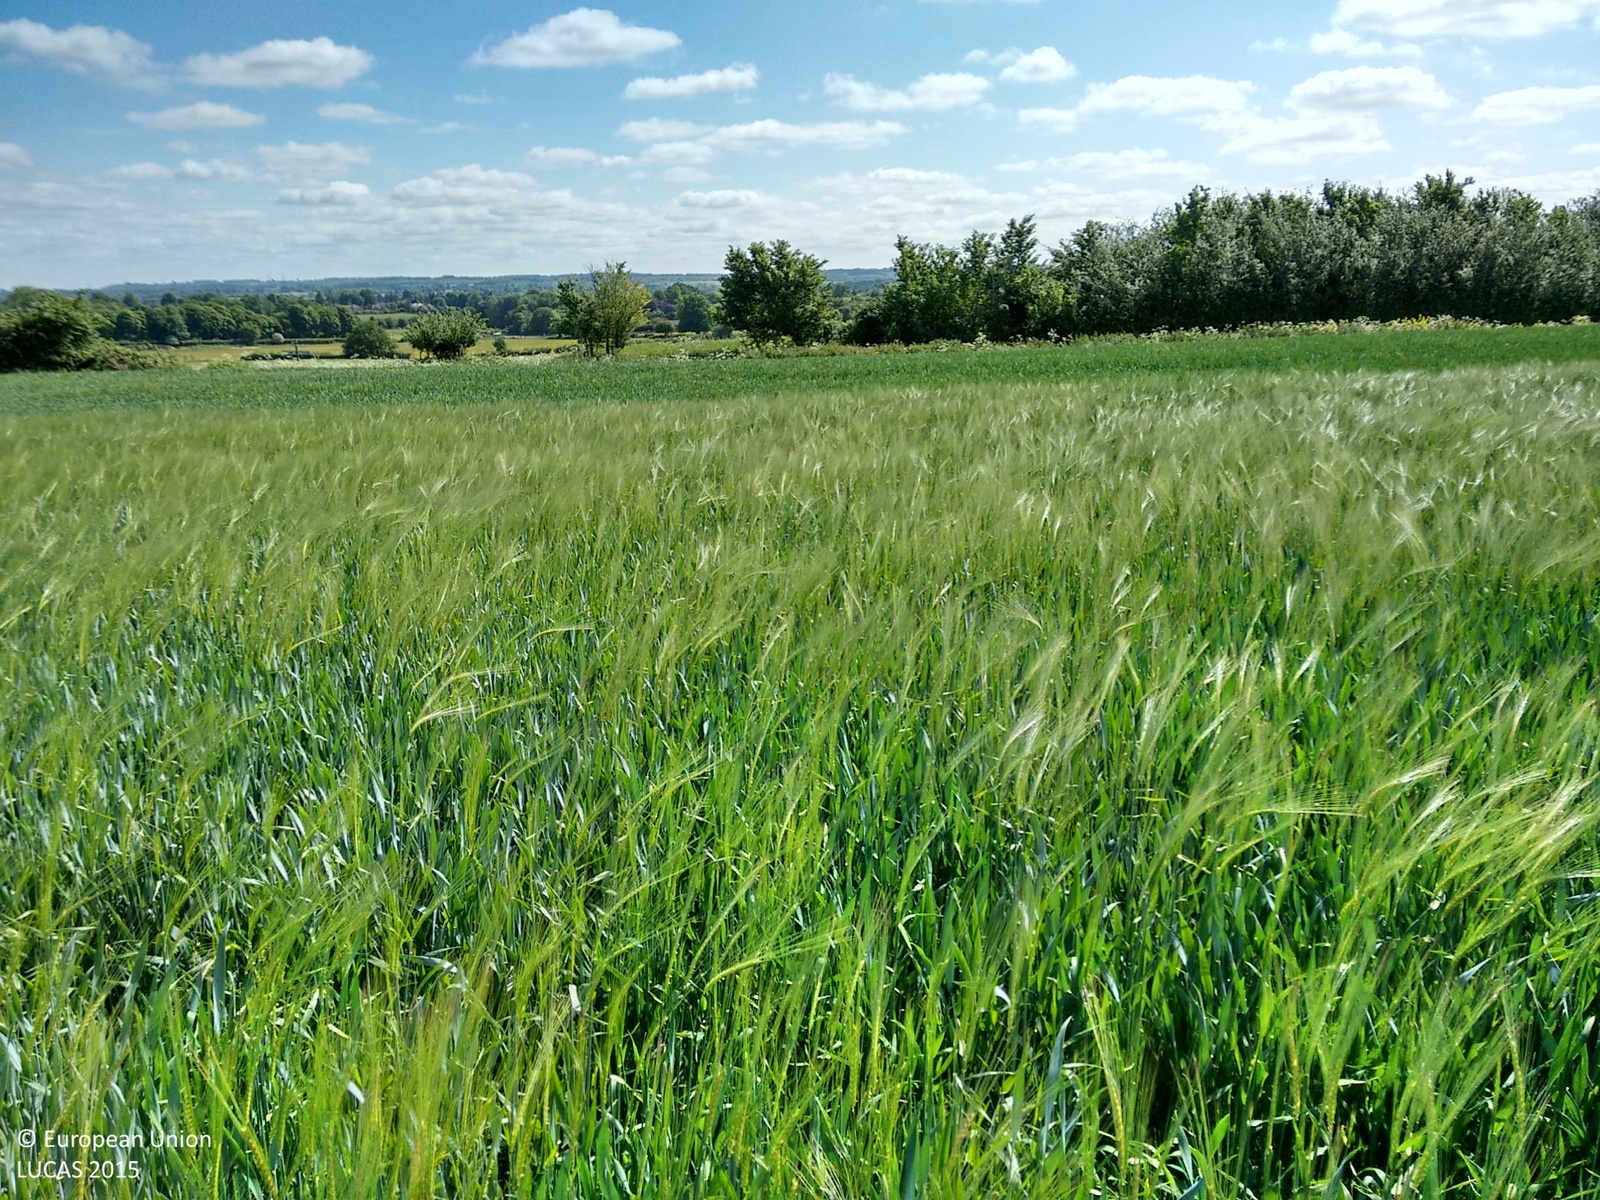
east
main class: Cropland
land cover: Common wheat
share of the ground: > 75 %
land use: Agriculture (excluding fallow land and kitchen gardens)
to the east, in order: Common wheat; Grass margins; Tracks; Managed hedges; Grass margins; Barley
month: May
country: GB
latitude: 51.9292
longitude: -0.2886
